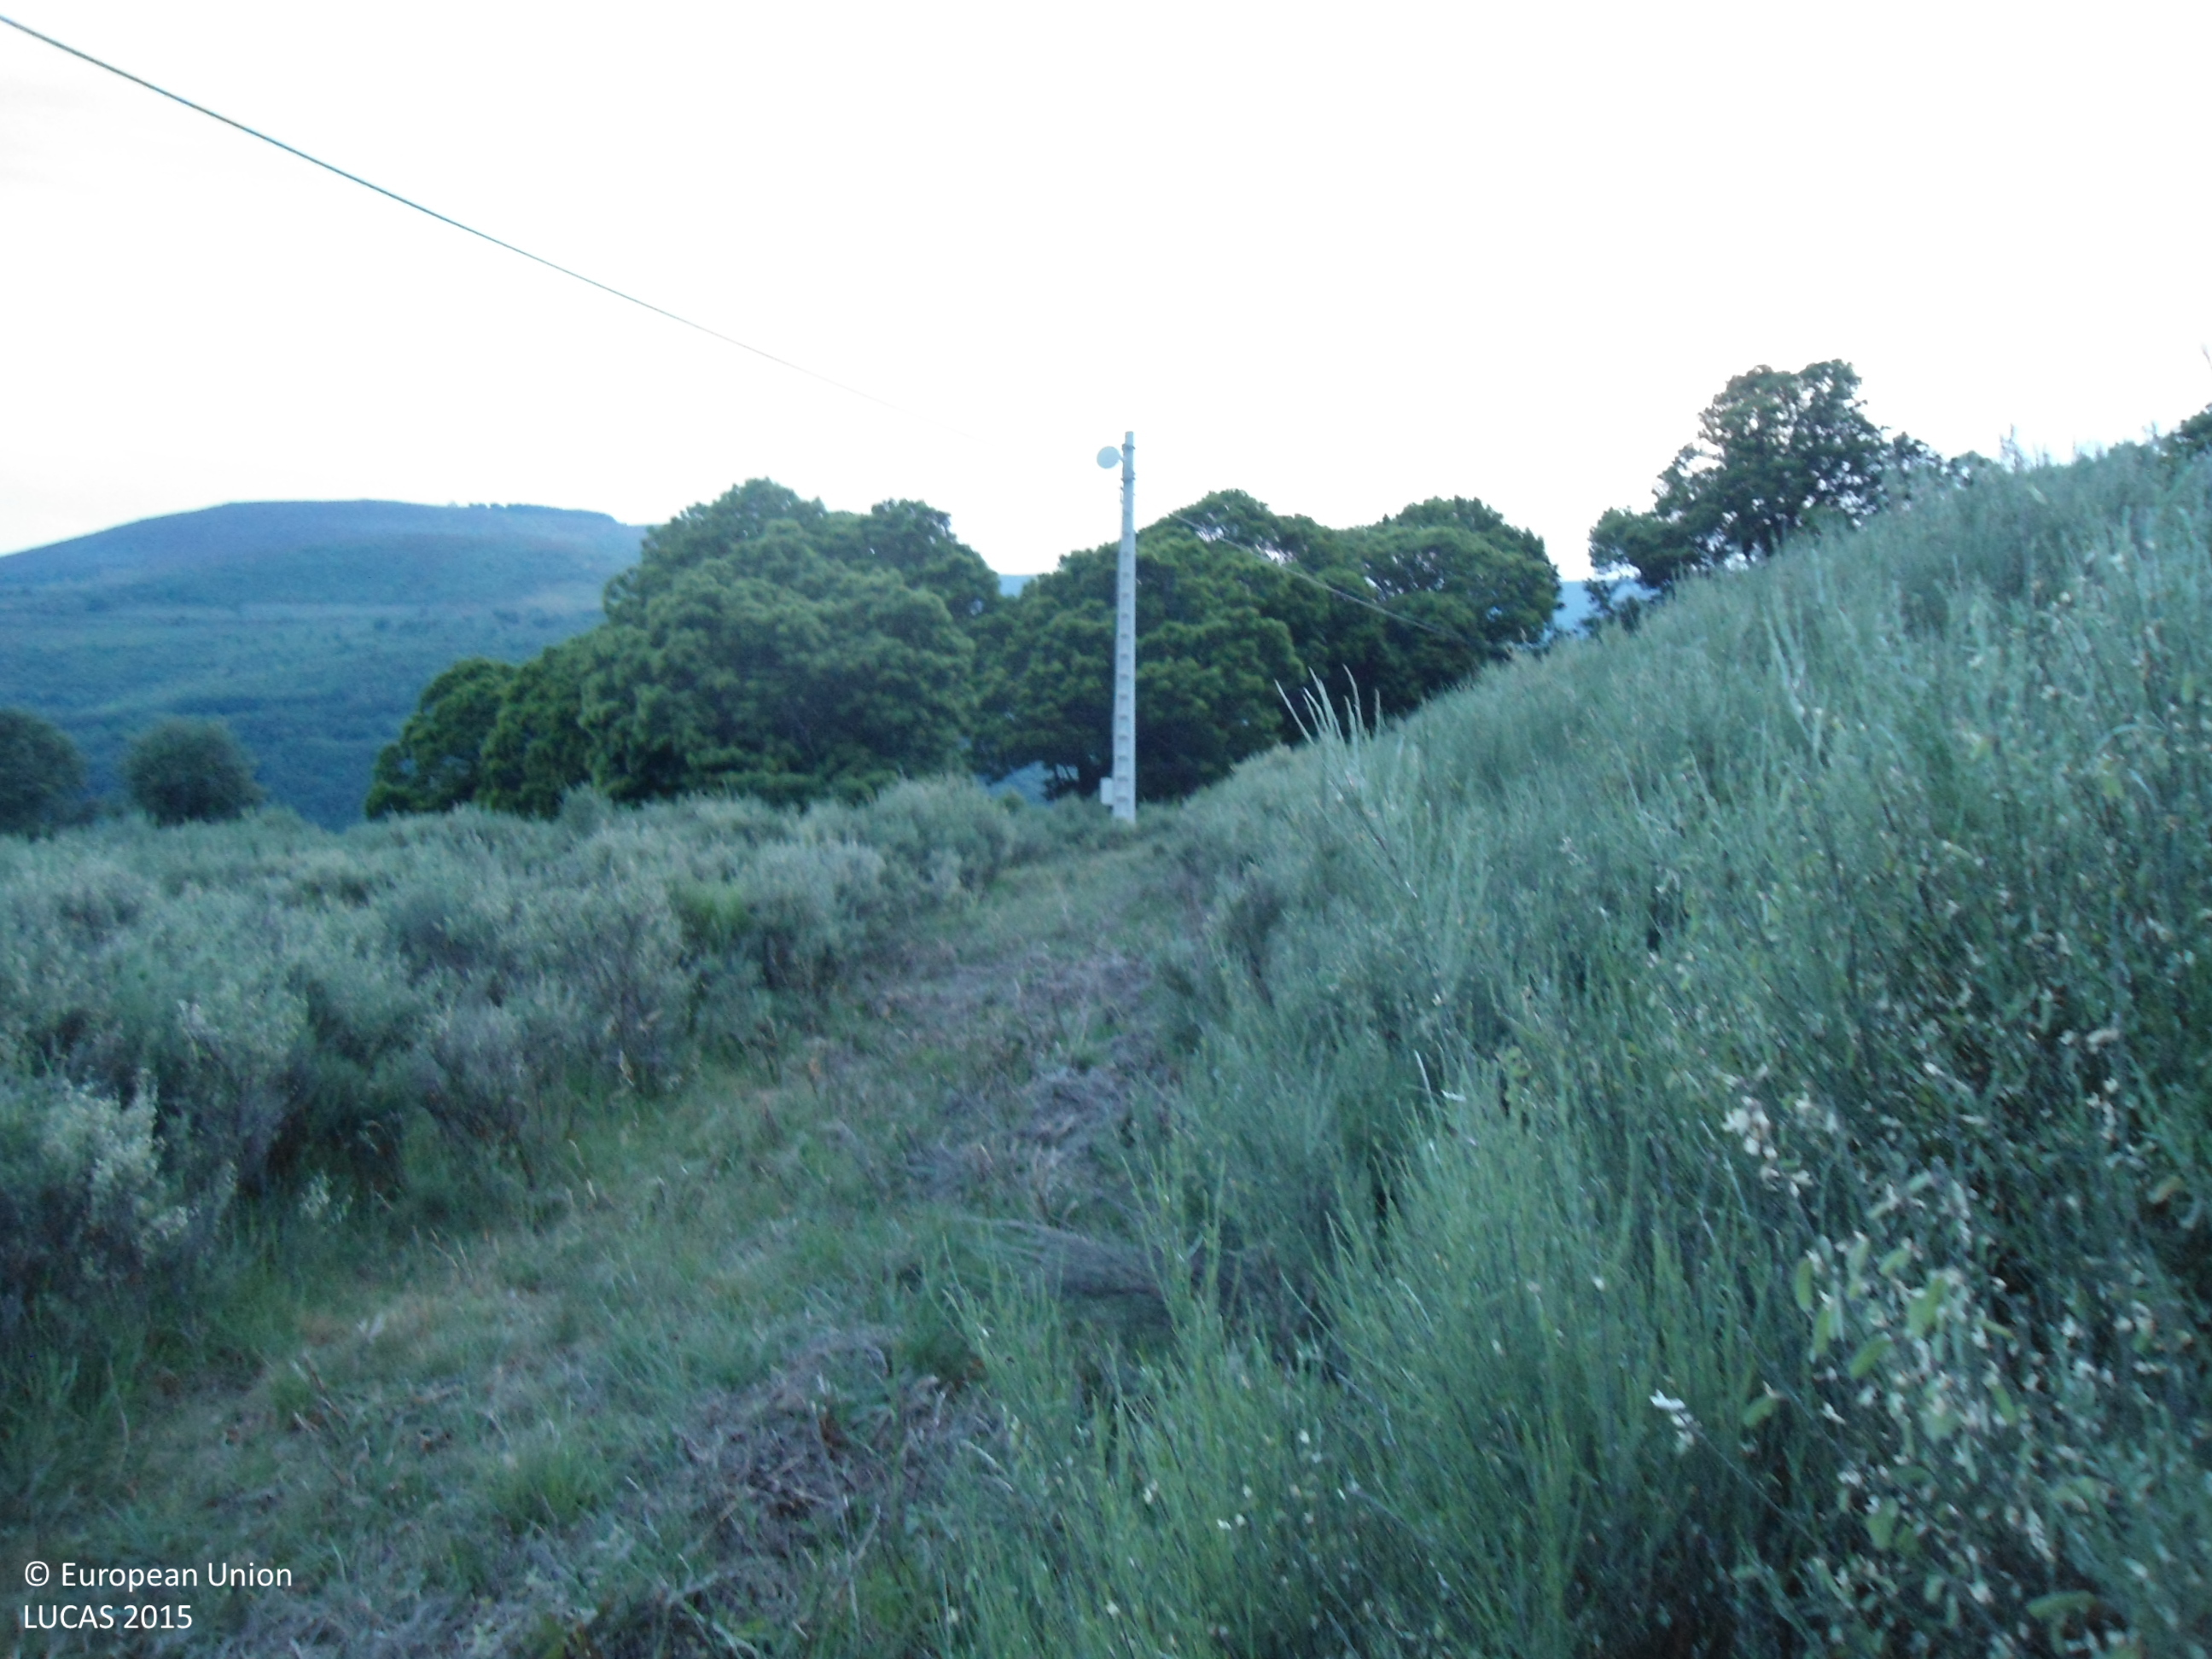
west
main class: Shrubland
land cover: Shrubland without tree cover
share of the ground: > 75 %
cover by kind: shrubs 100 %
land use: Semi-natural and natural areas not in use
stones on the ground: < 10 %
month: June
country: ES
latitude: 42.1505
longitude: -6.6334
